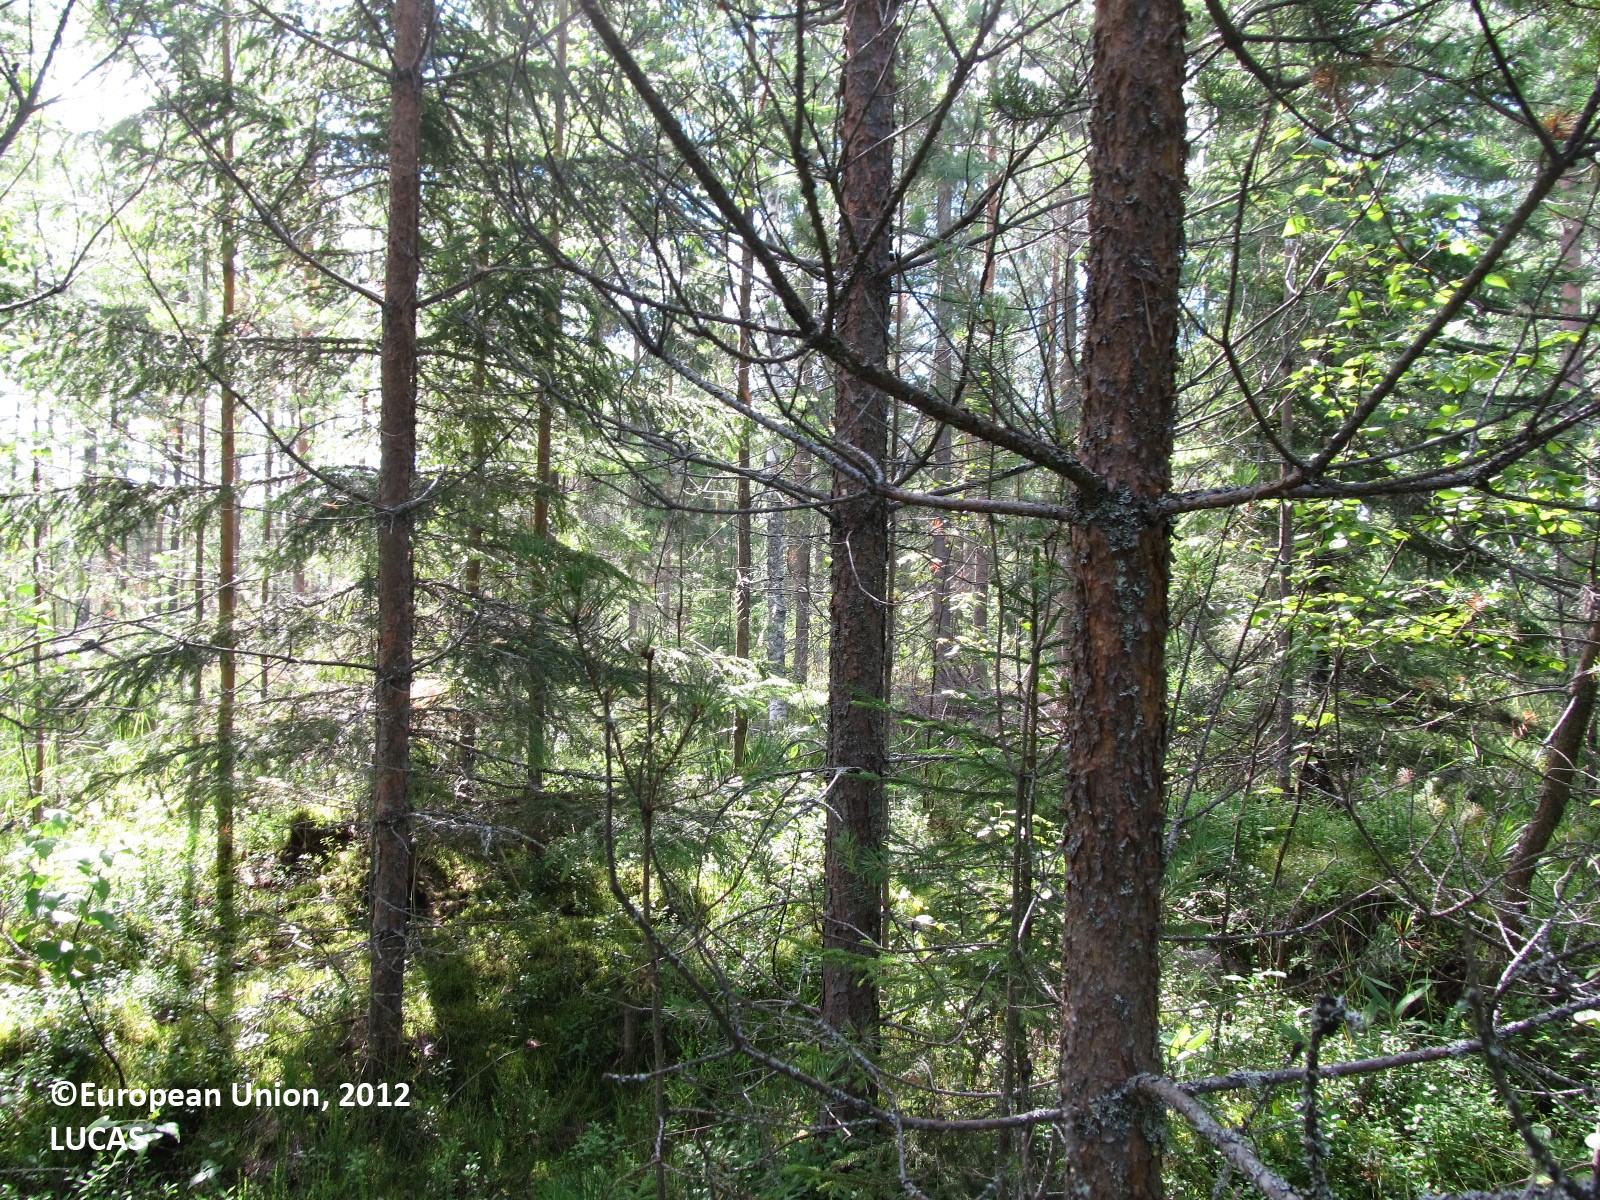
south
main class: Woodland
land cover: Pine dominated mixed woodland
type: boreal forest
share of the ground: 50 - 75 %
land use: Forestry
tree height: > 5 m
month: July
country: FI
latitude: 62.0221
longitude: 27.9377
